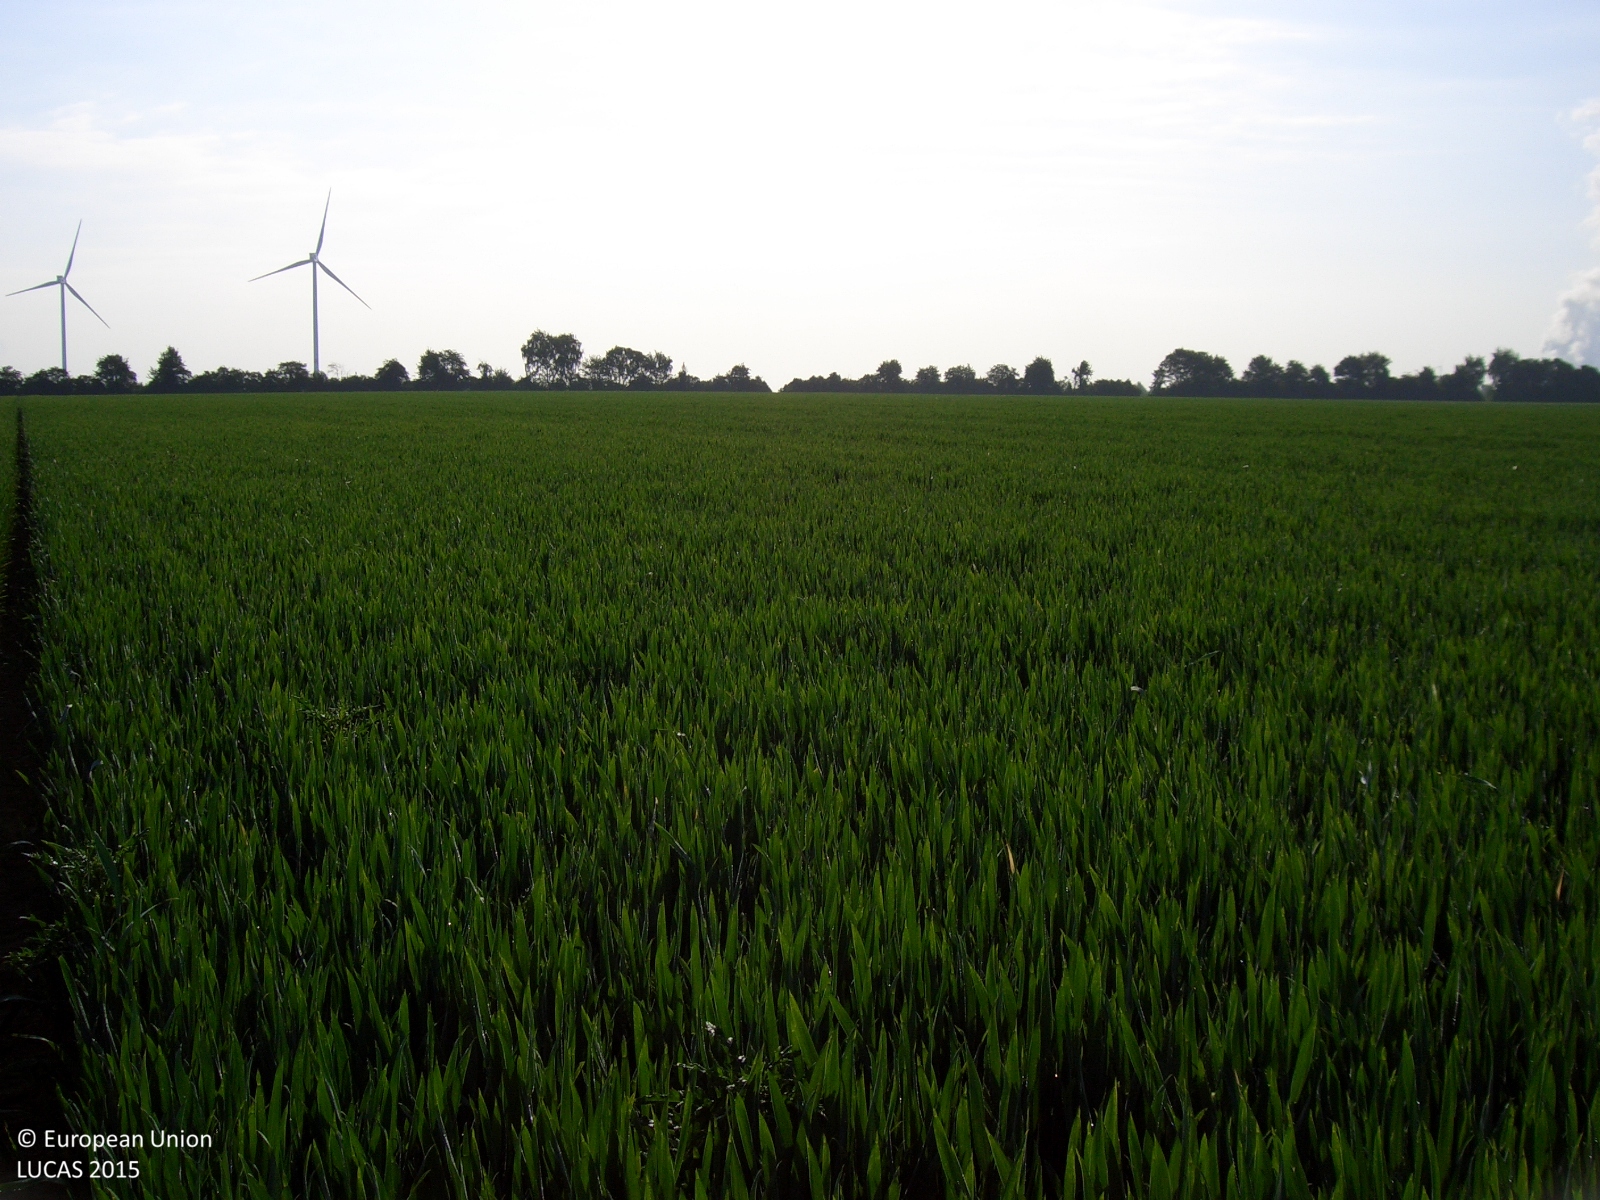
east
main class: Cropland
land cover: Common wheat
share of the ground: > 75 %
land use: Agriculture (excluding fallow land and kitchen gardens)
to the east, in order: Common wheat
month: June
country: DE
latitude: 50.8601
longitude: 6.2344
